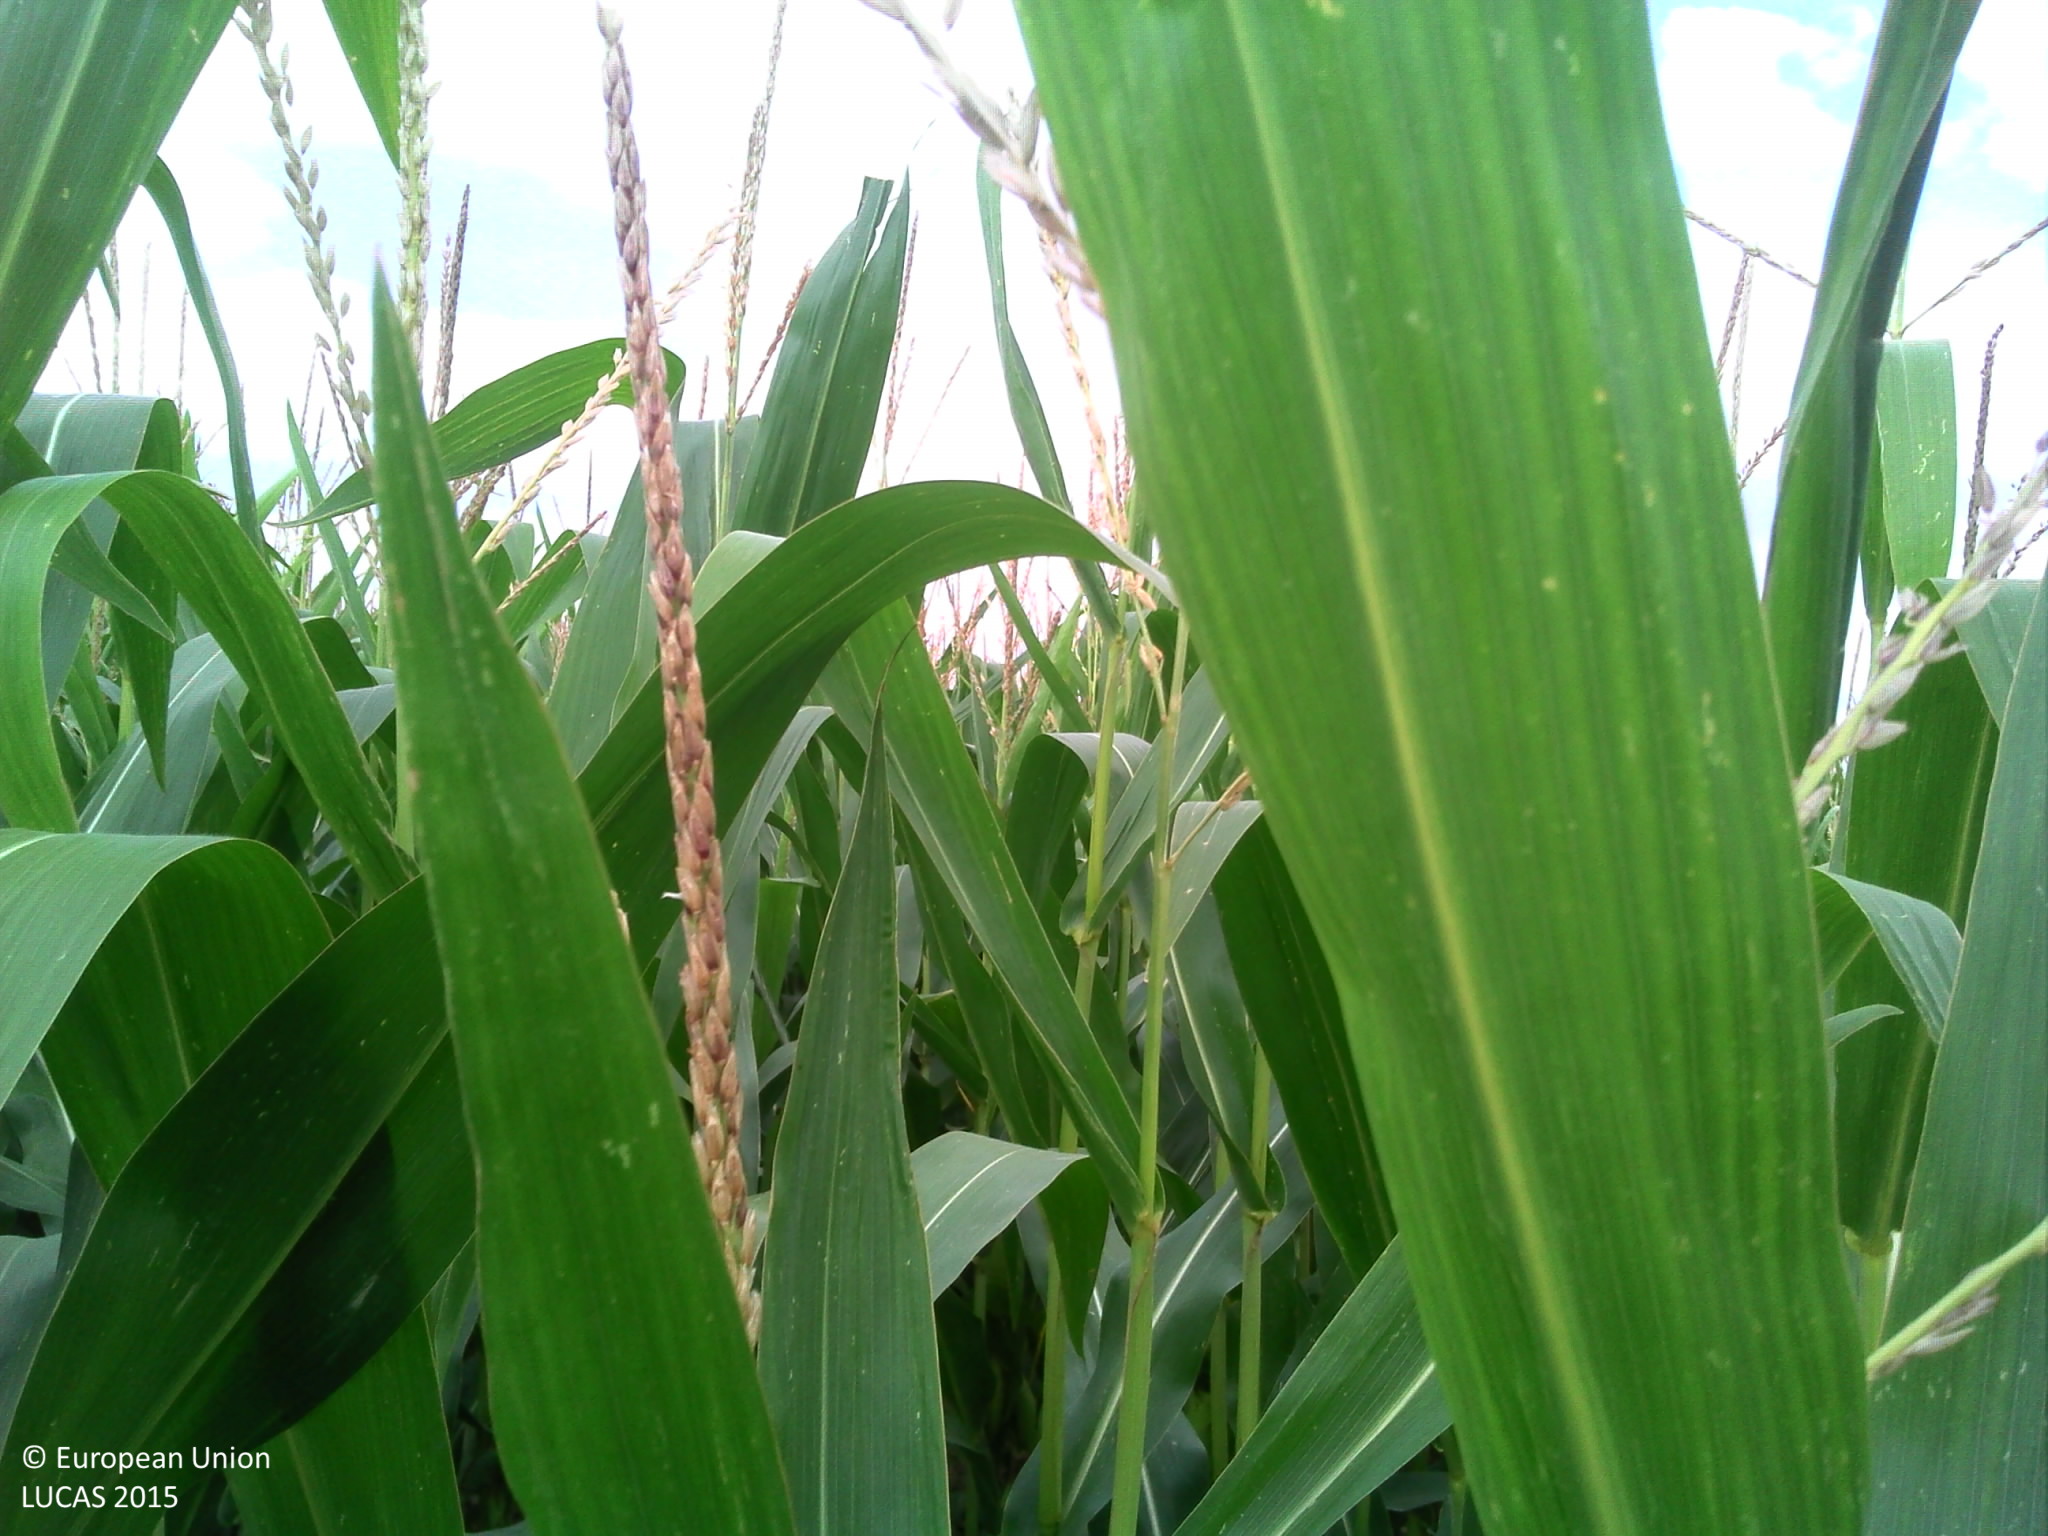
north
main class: Cropland
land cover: Maize
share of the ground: > 75 %
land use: Agriculture (excluding fallow land and kitchen gardens)
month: August
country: FR
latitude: 46.6234
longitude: -1.1217
